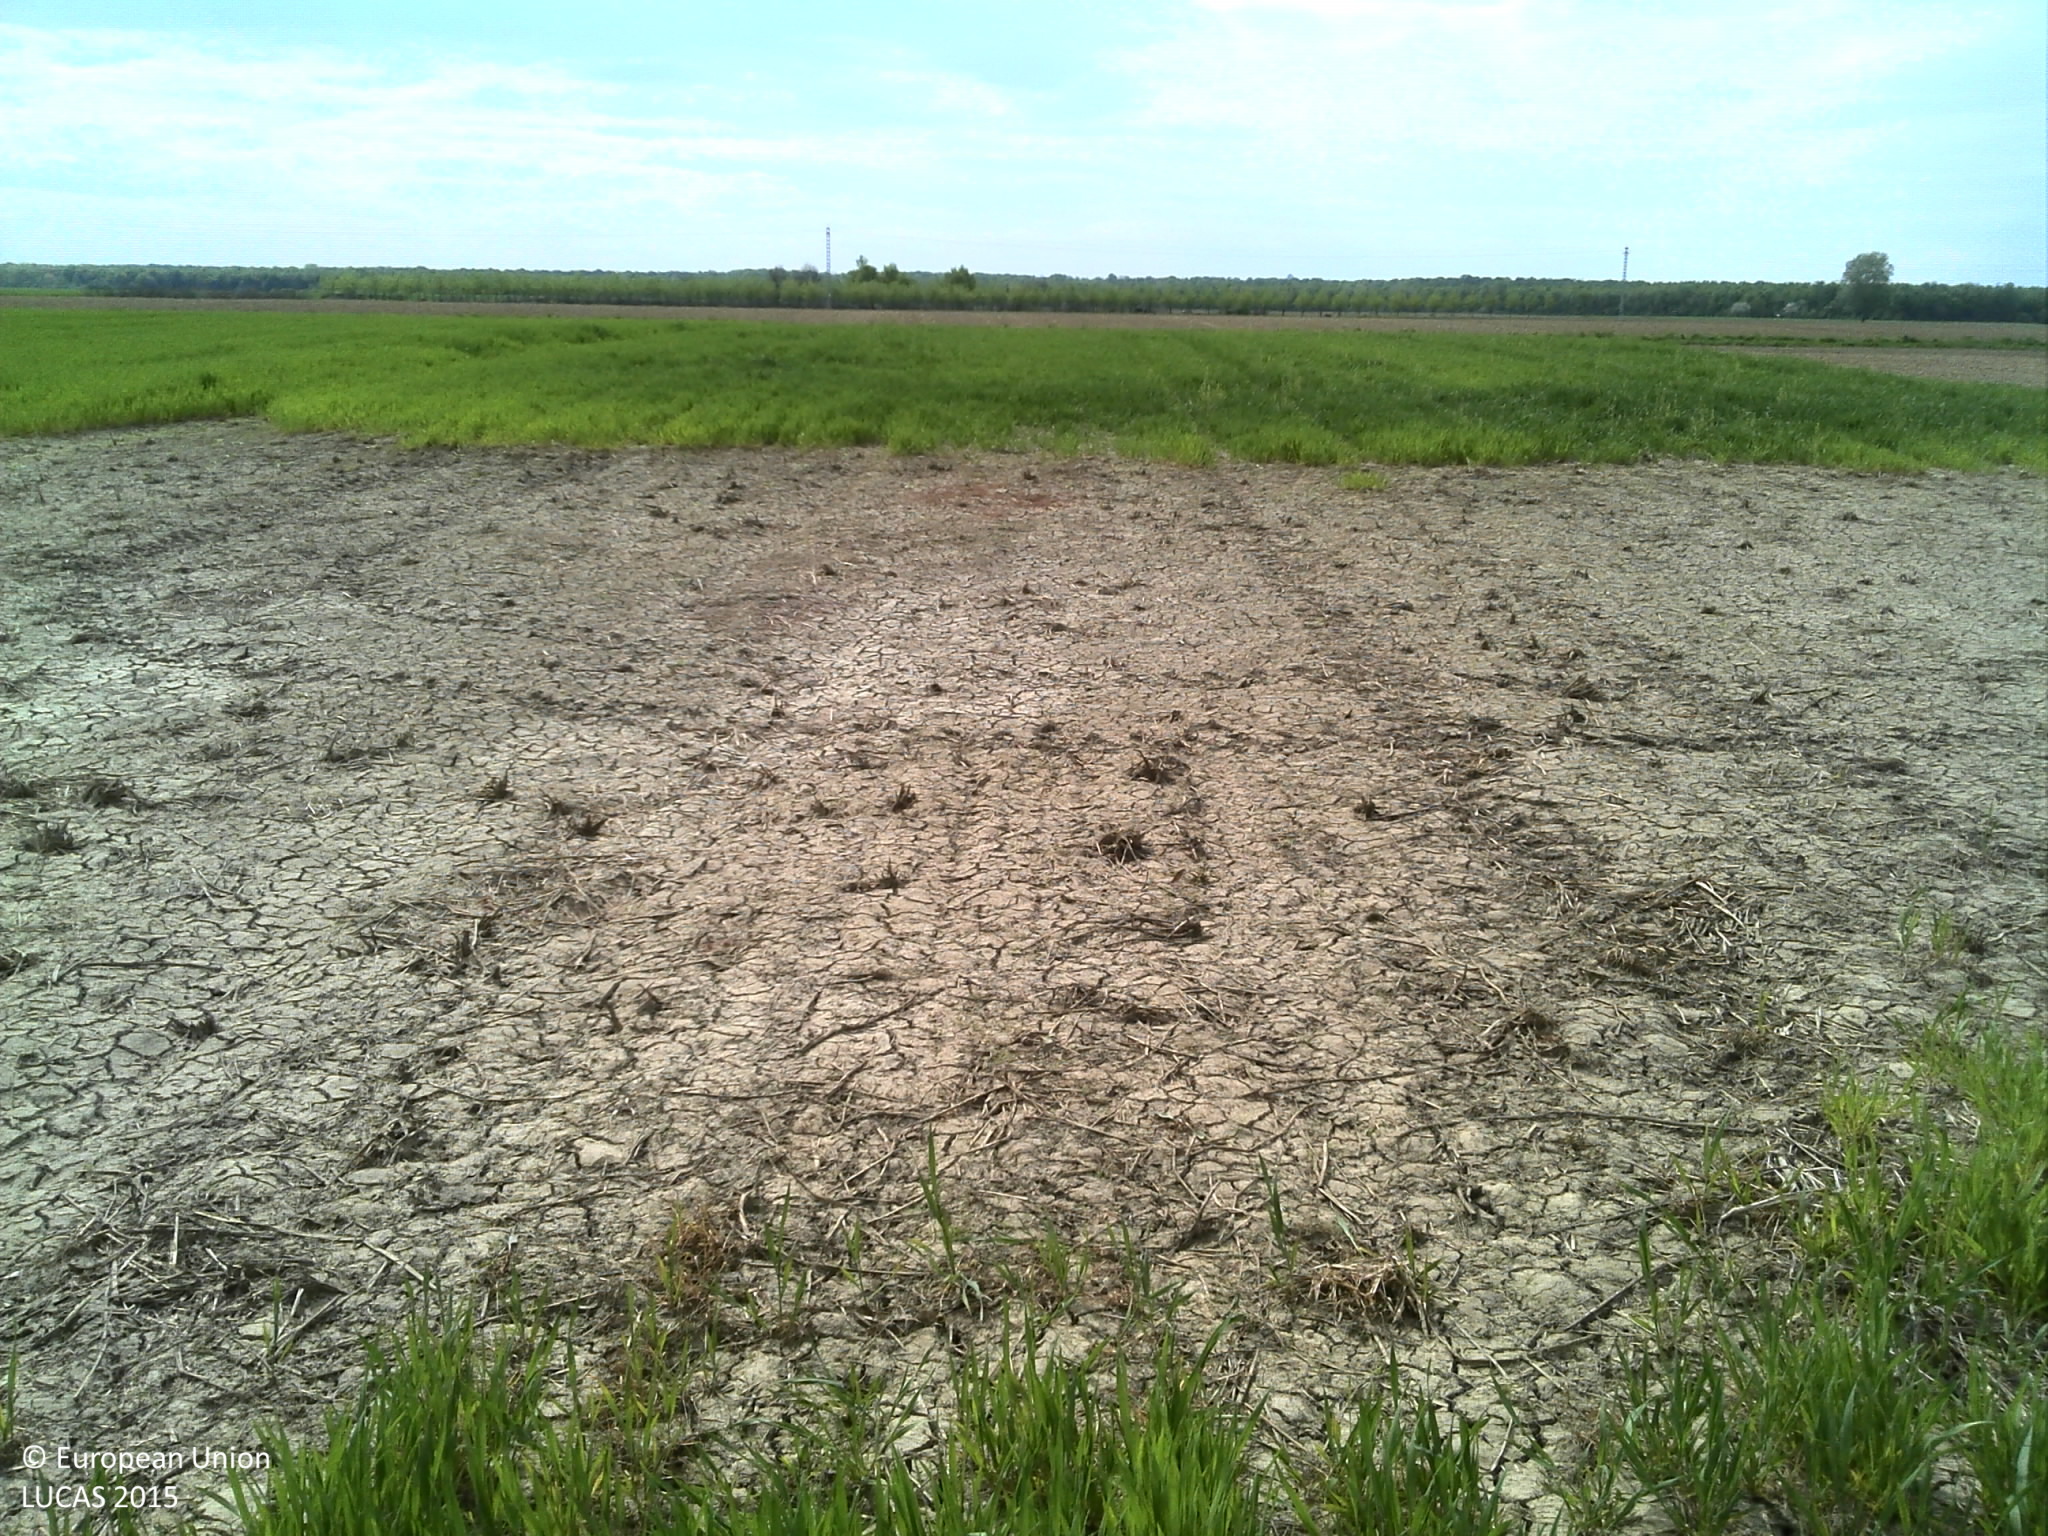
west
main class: Cropland
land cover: Common wheat
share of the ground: > 75 %
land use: Agriculture (excluding fallow land and kitchen gardens)
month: April
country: HR
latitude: 44.9989
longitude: 18.9246
